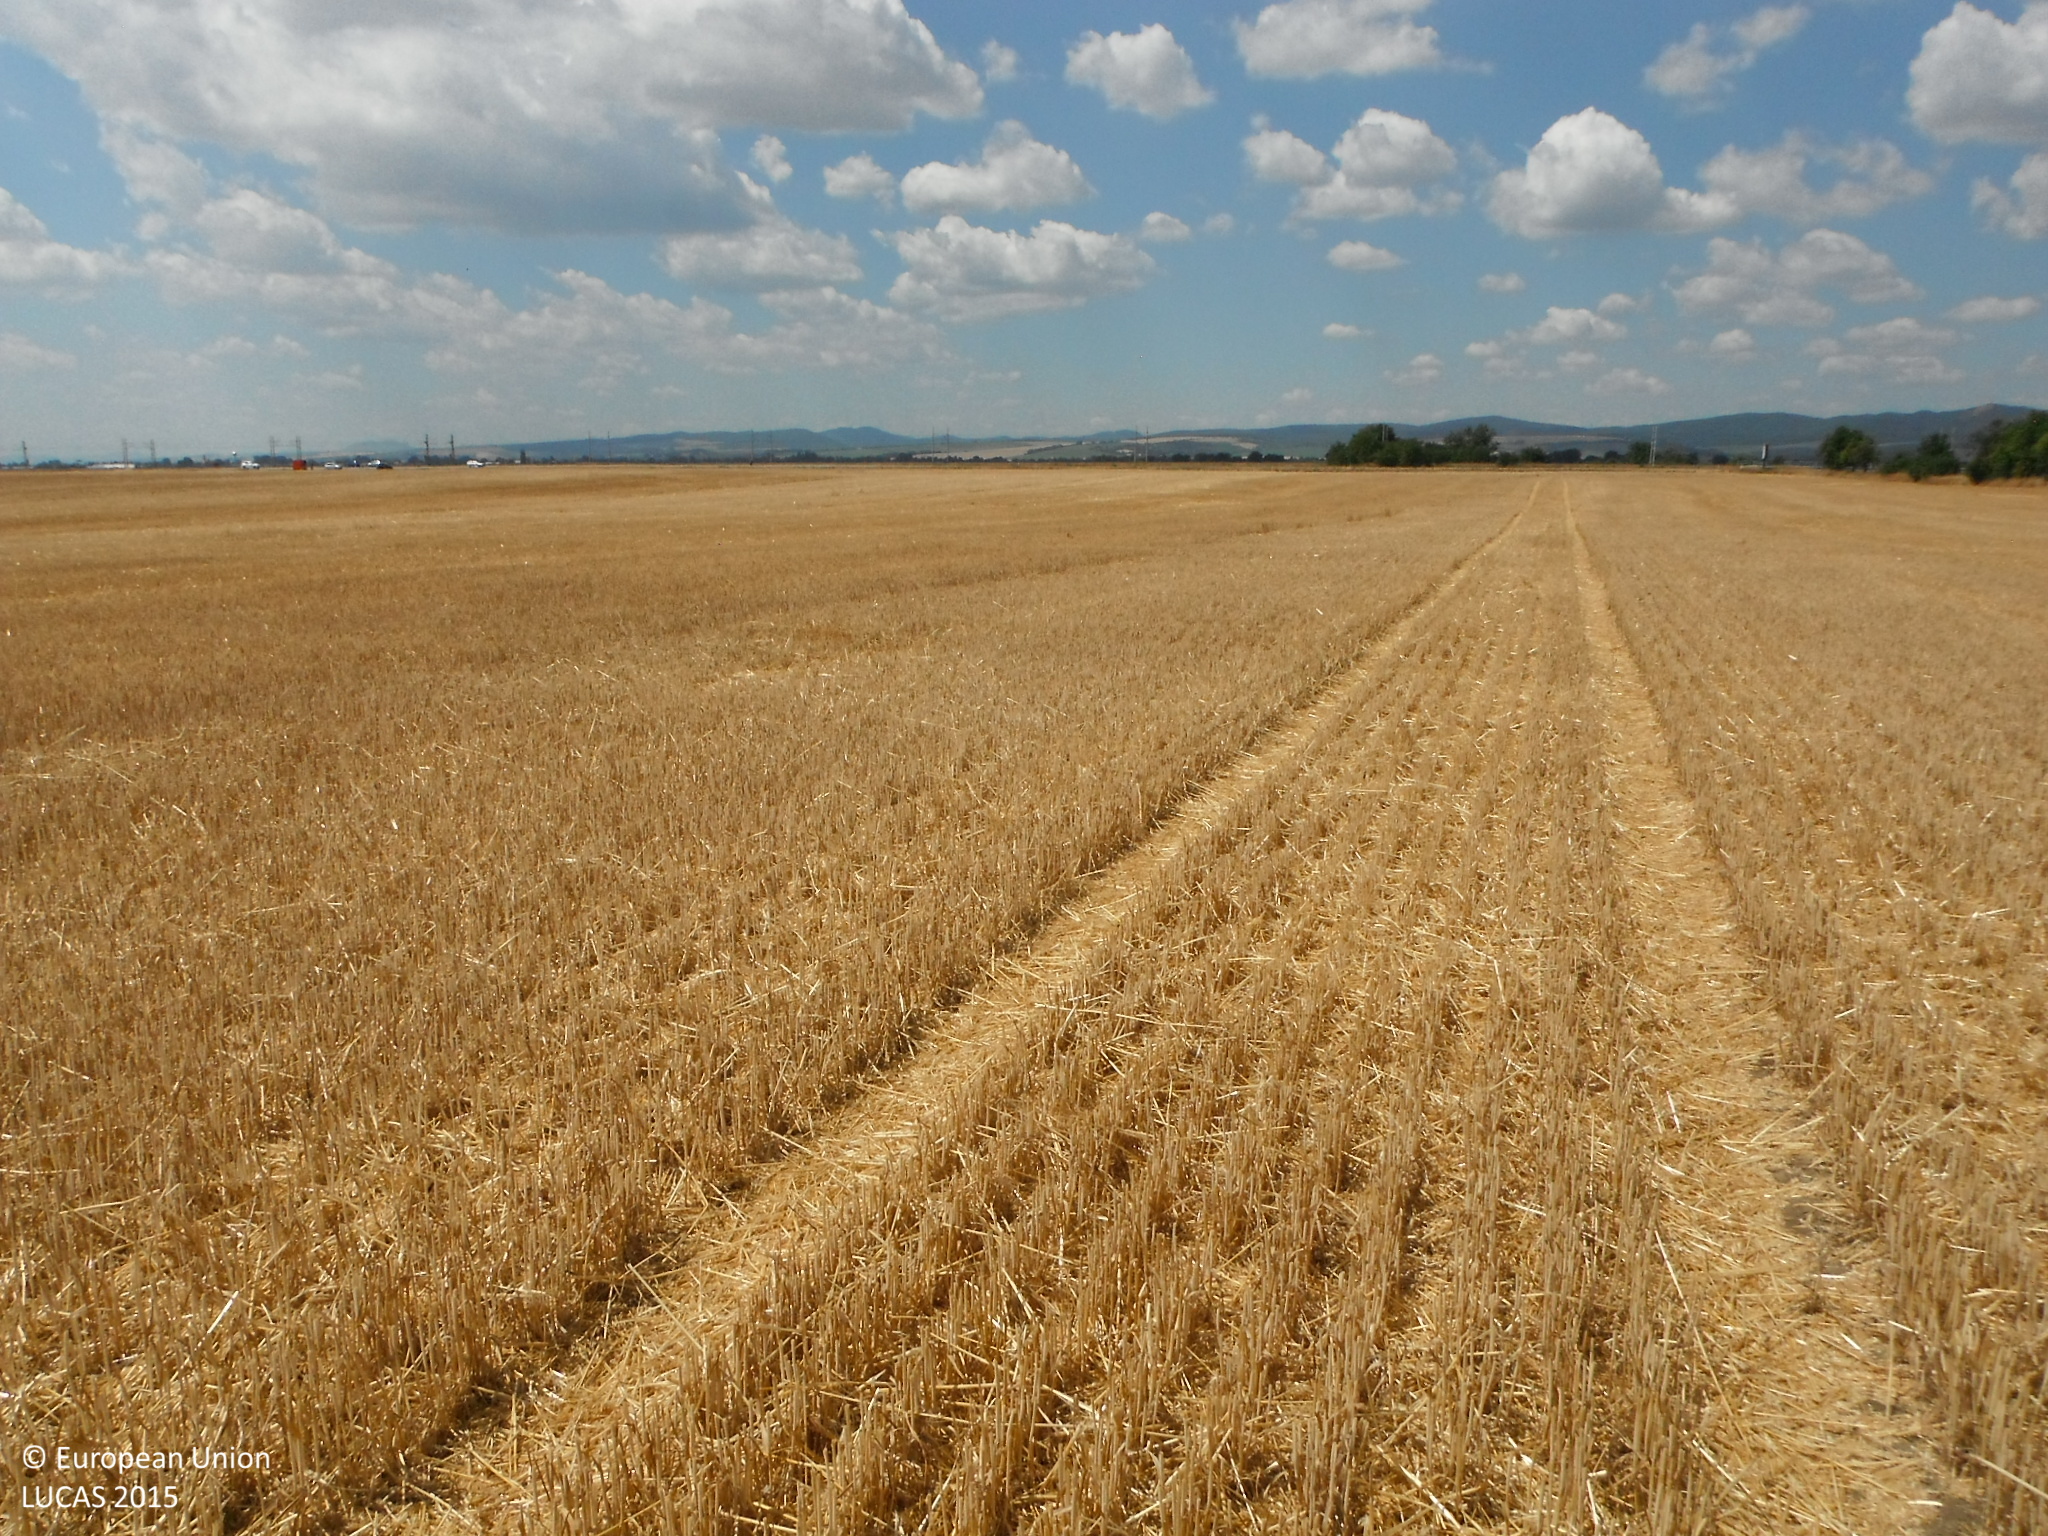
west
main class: Cropland
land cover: Common wheat
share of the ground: > 75 %
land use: Agriculture (excluding fallow land and kitchen gardens)
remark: Harvested field
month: July
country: SK
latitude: 48.6666
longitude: 17.8476
